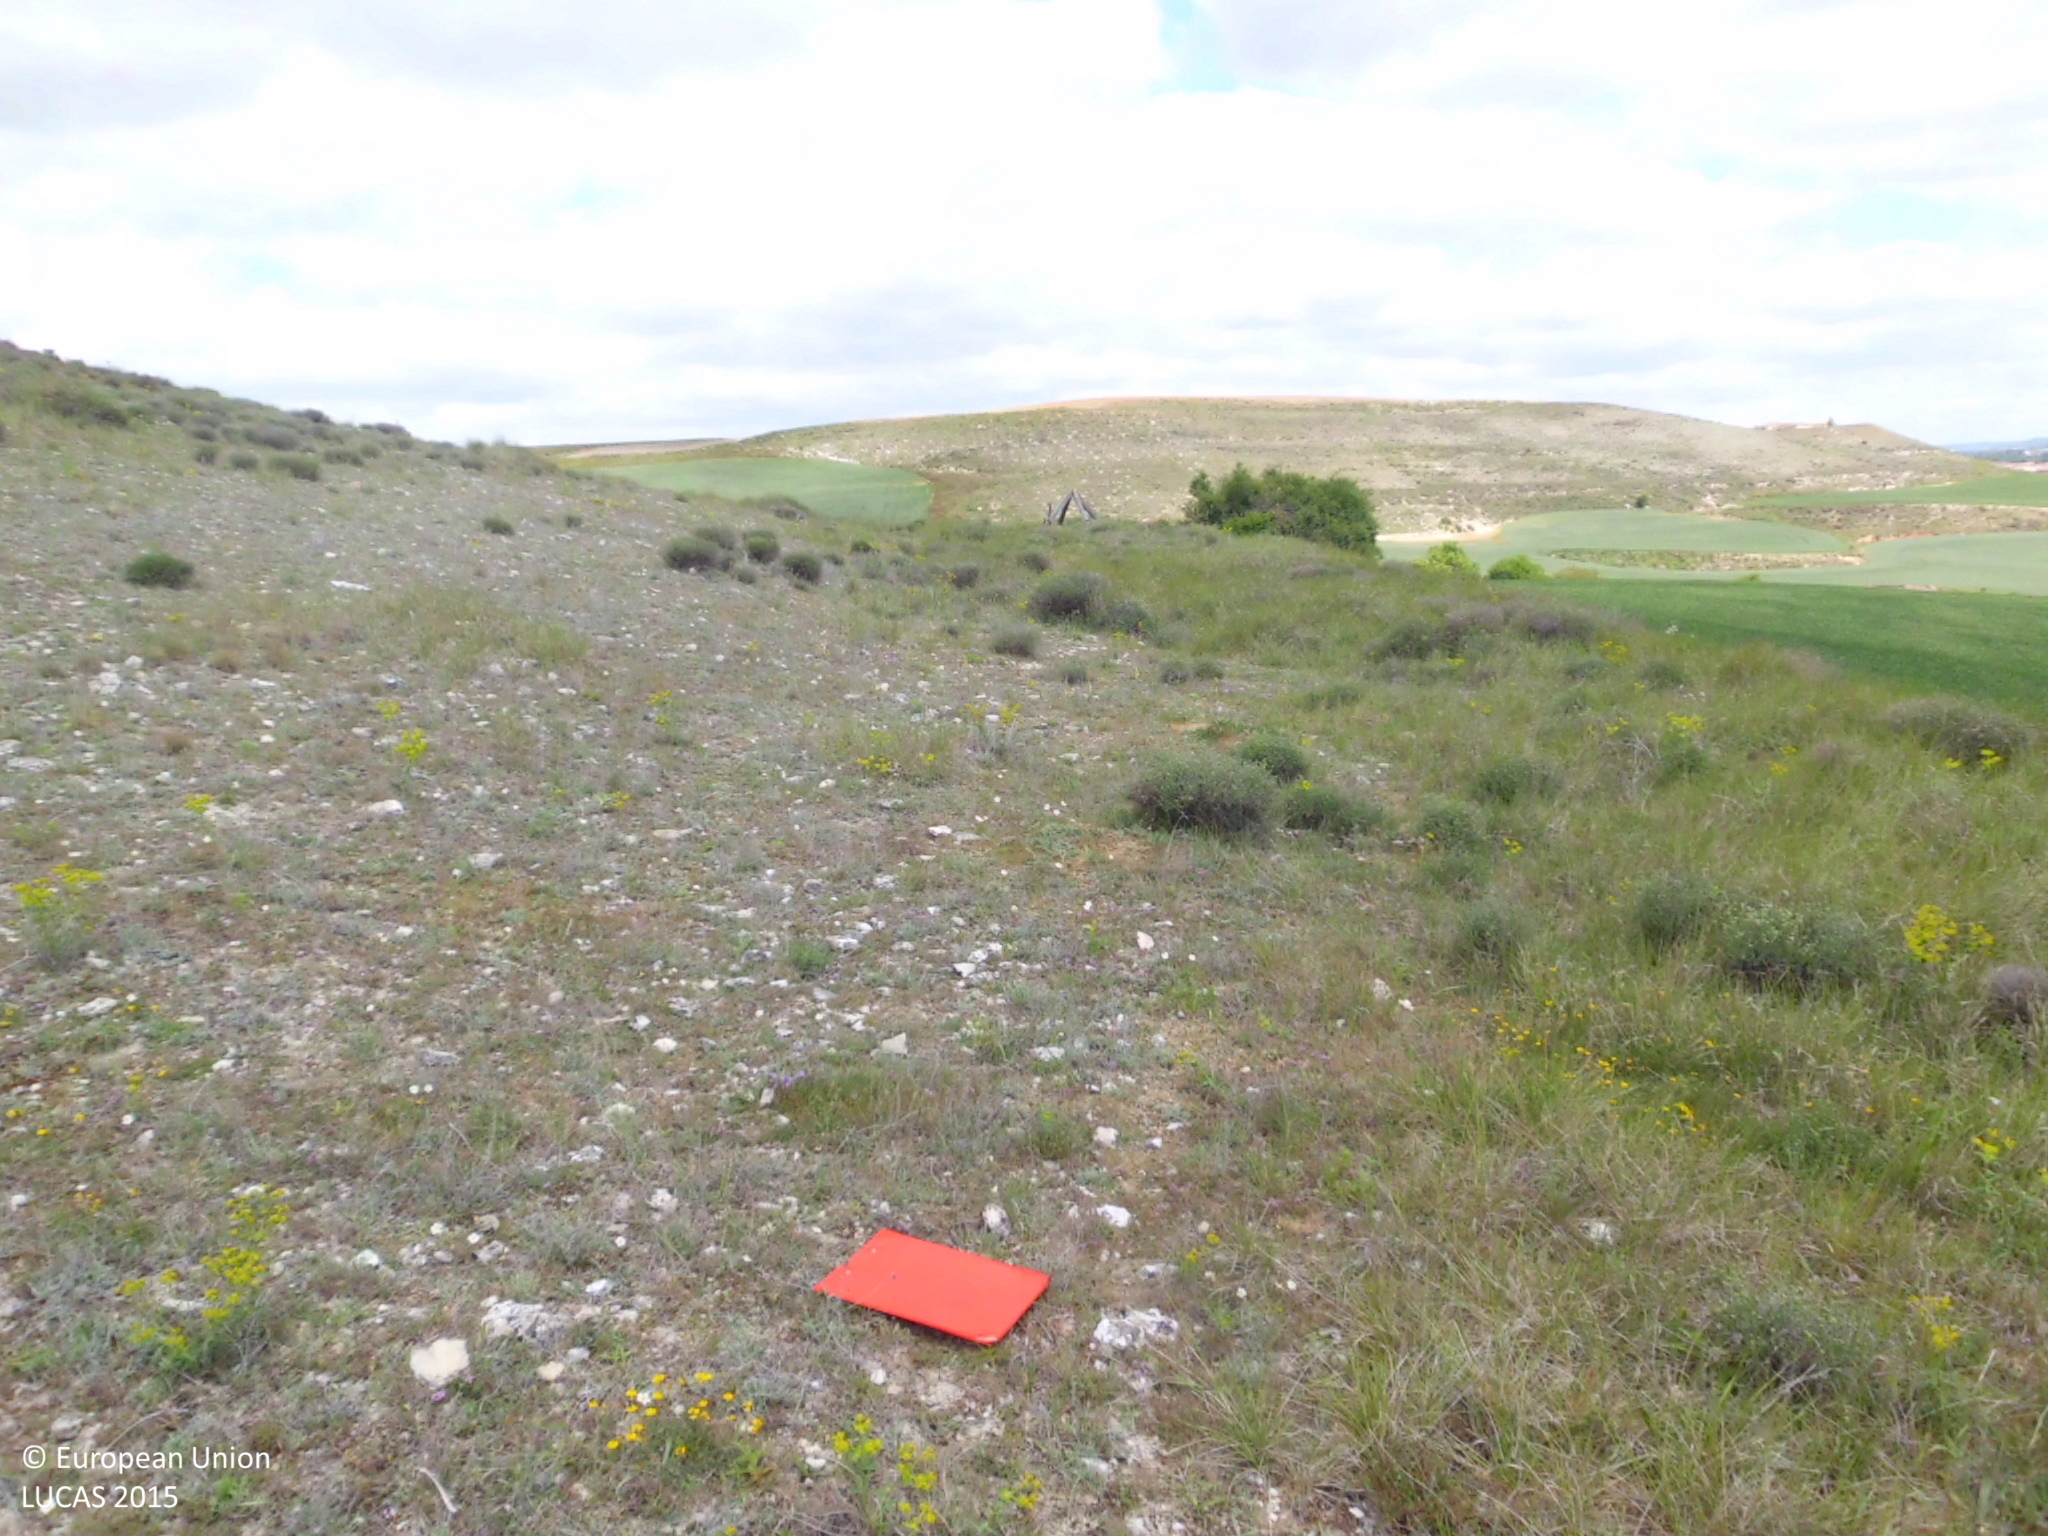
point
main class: Grassland
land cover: Grassland without tree/shrub cover
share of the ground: > 75 %
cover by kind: herbaceous plants 95 %, shrubs 5 %
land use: Semi-natural and natural areas not in use
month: May
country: ES
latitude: 42.3005
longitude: -3.8543
